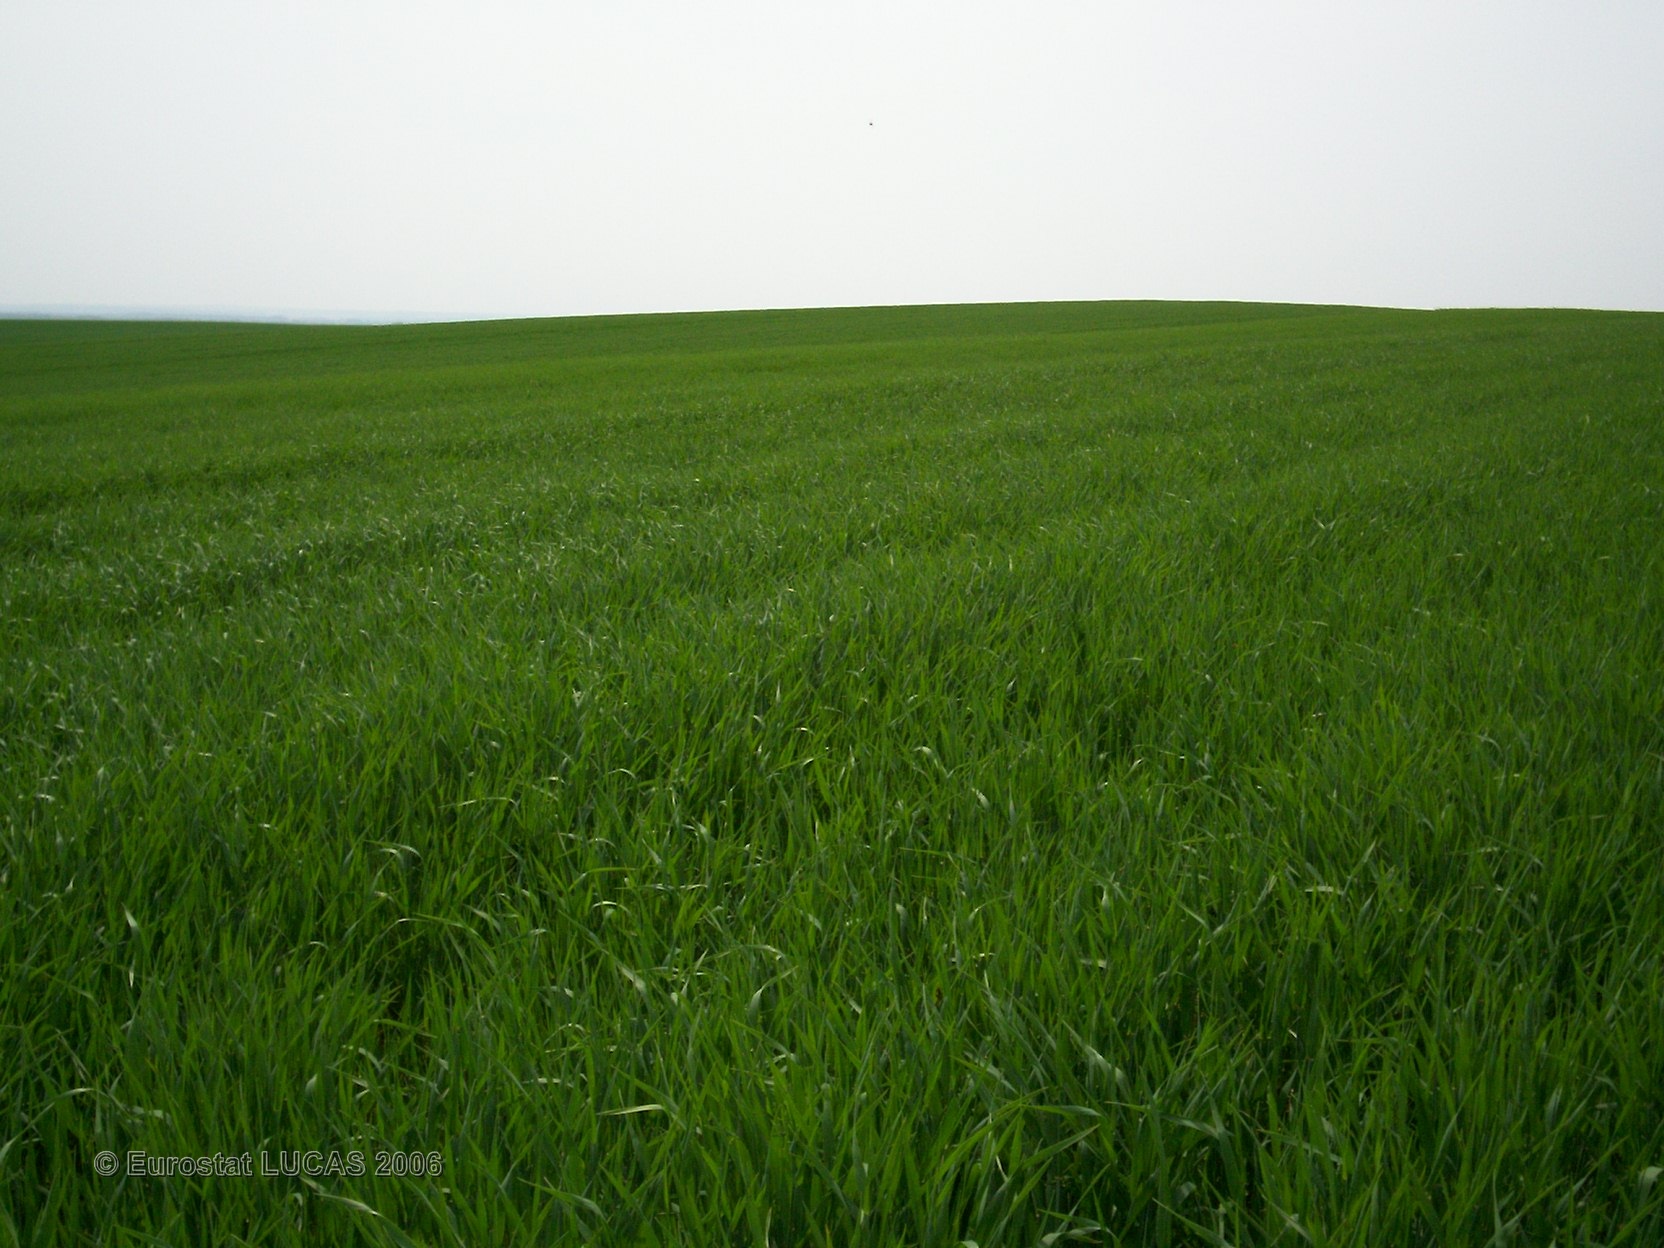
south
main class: Cropland
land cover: Barley
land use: Agriculture (excluding fallow land and kitchen gardens)
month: May
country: FR
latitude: 48.0855
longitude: 3.8071
